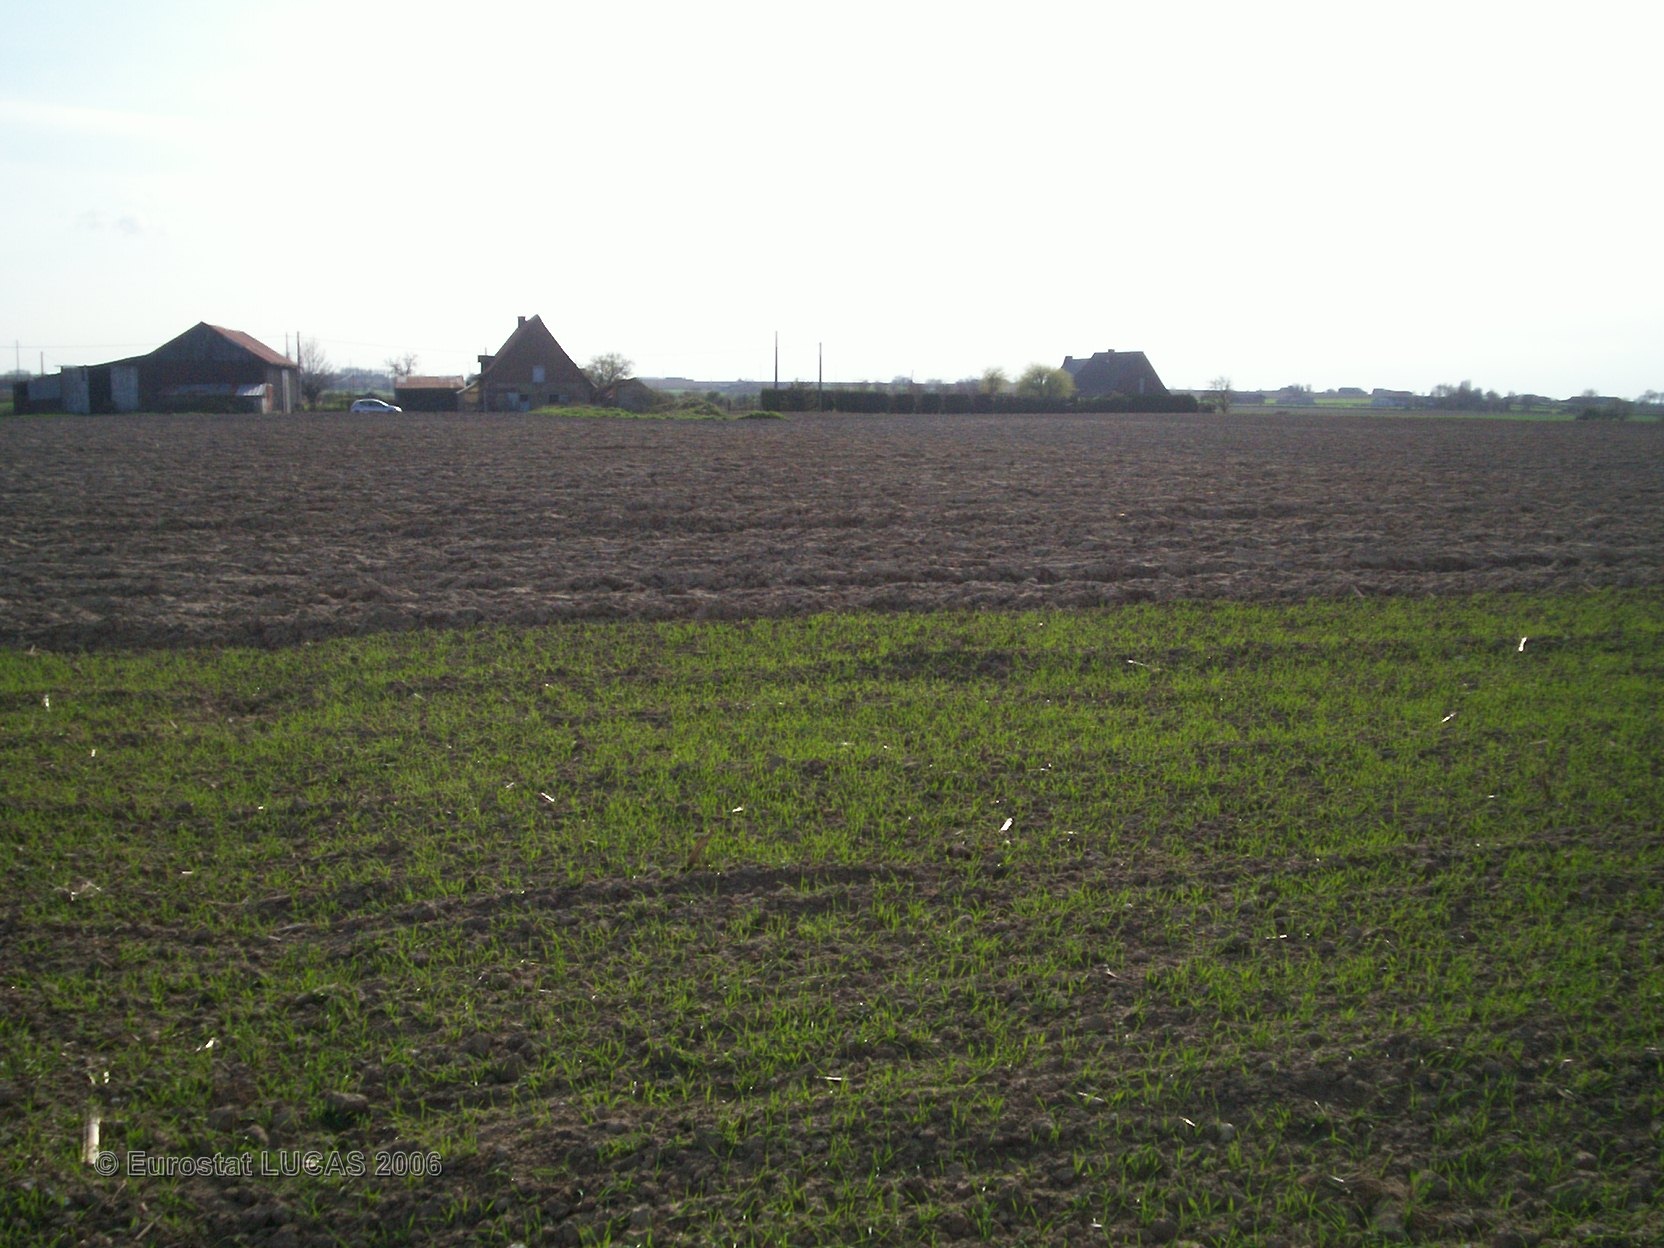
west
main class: Cropland
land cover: Common wheat
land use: Agriculture (excluding fallow land and kitchen gardens)
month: April
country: FR
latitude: 50.8384
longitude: 2.4751
